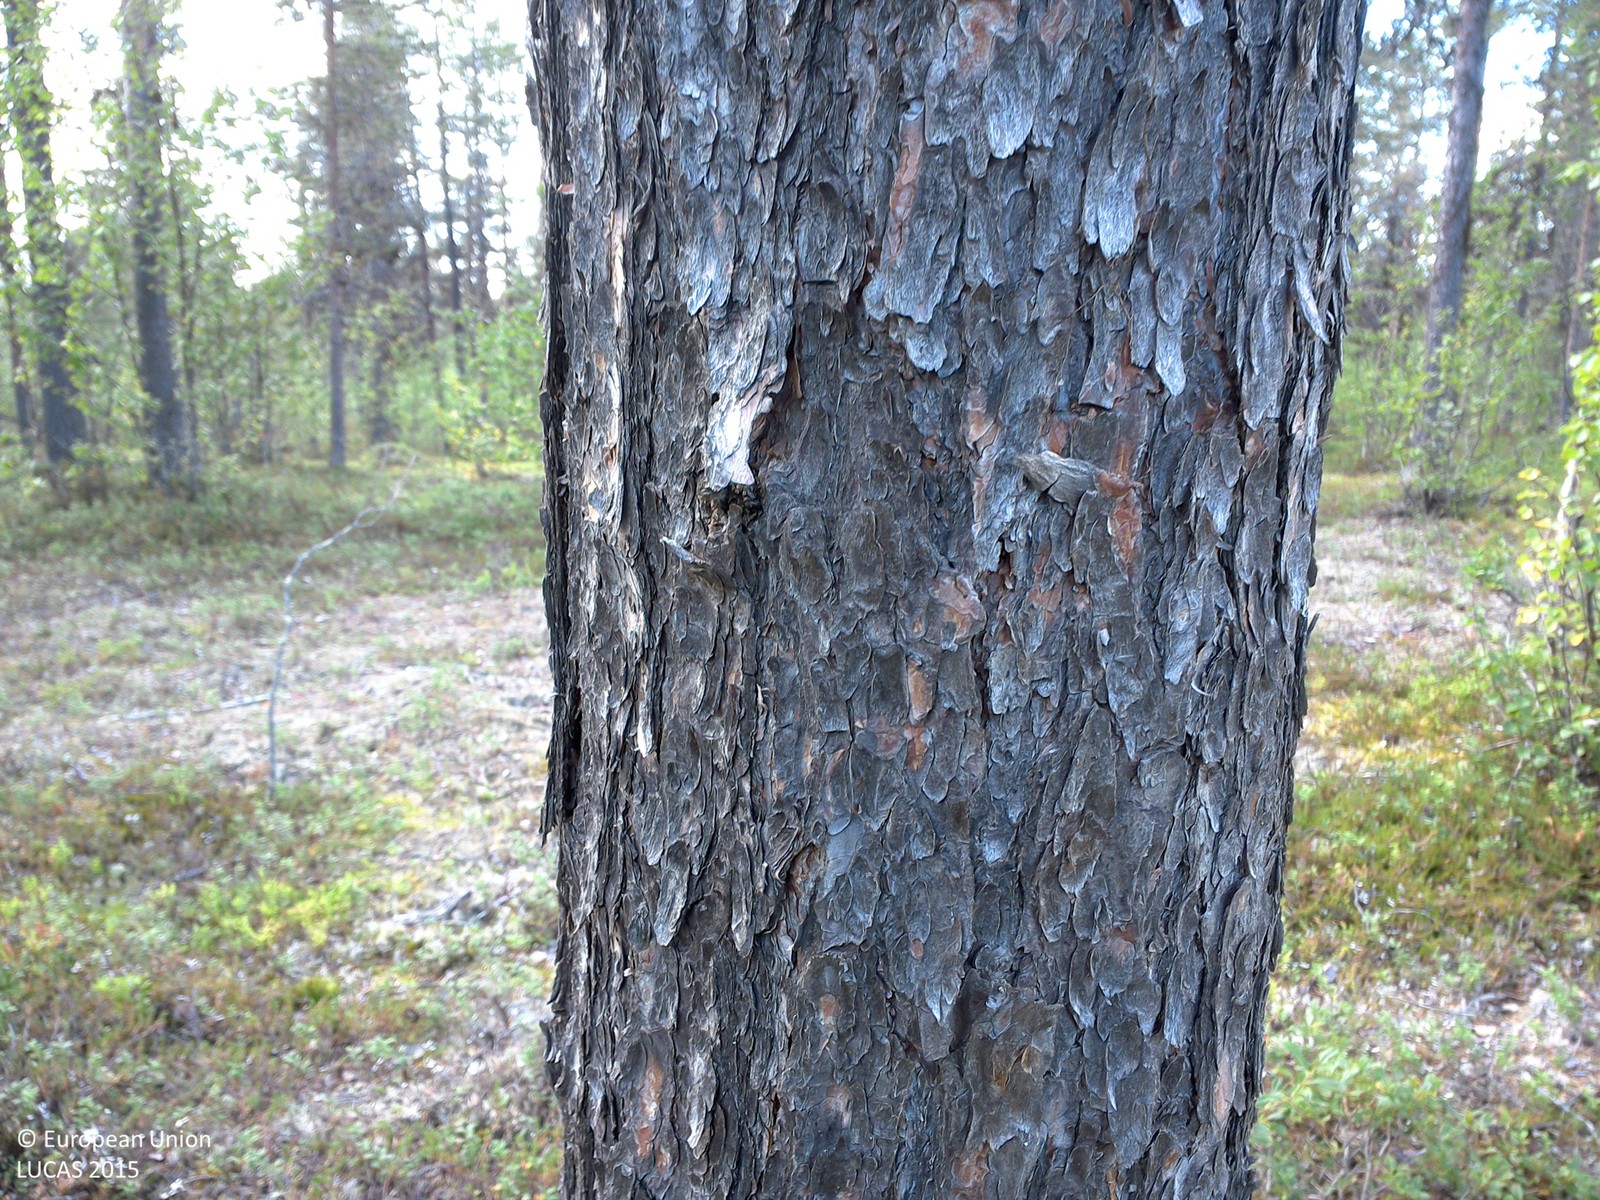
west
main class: Woodland
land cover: Pine dominated mixed woodland
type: boreal forest
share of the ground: 25 - 50 %
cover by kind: shrubs 60 %, coniferous forest trees 25 %, broadleaved forest trees 10 %, lichens and mosses 5 %
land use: Forestry
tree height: > 5 m
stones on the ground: < 10 %
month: August
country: SE
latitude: 68.1600
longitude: 23.0814
